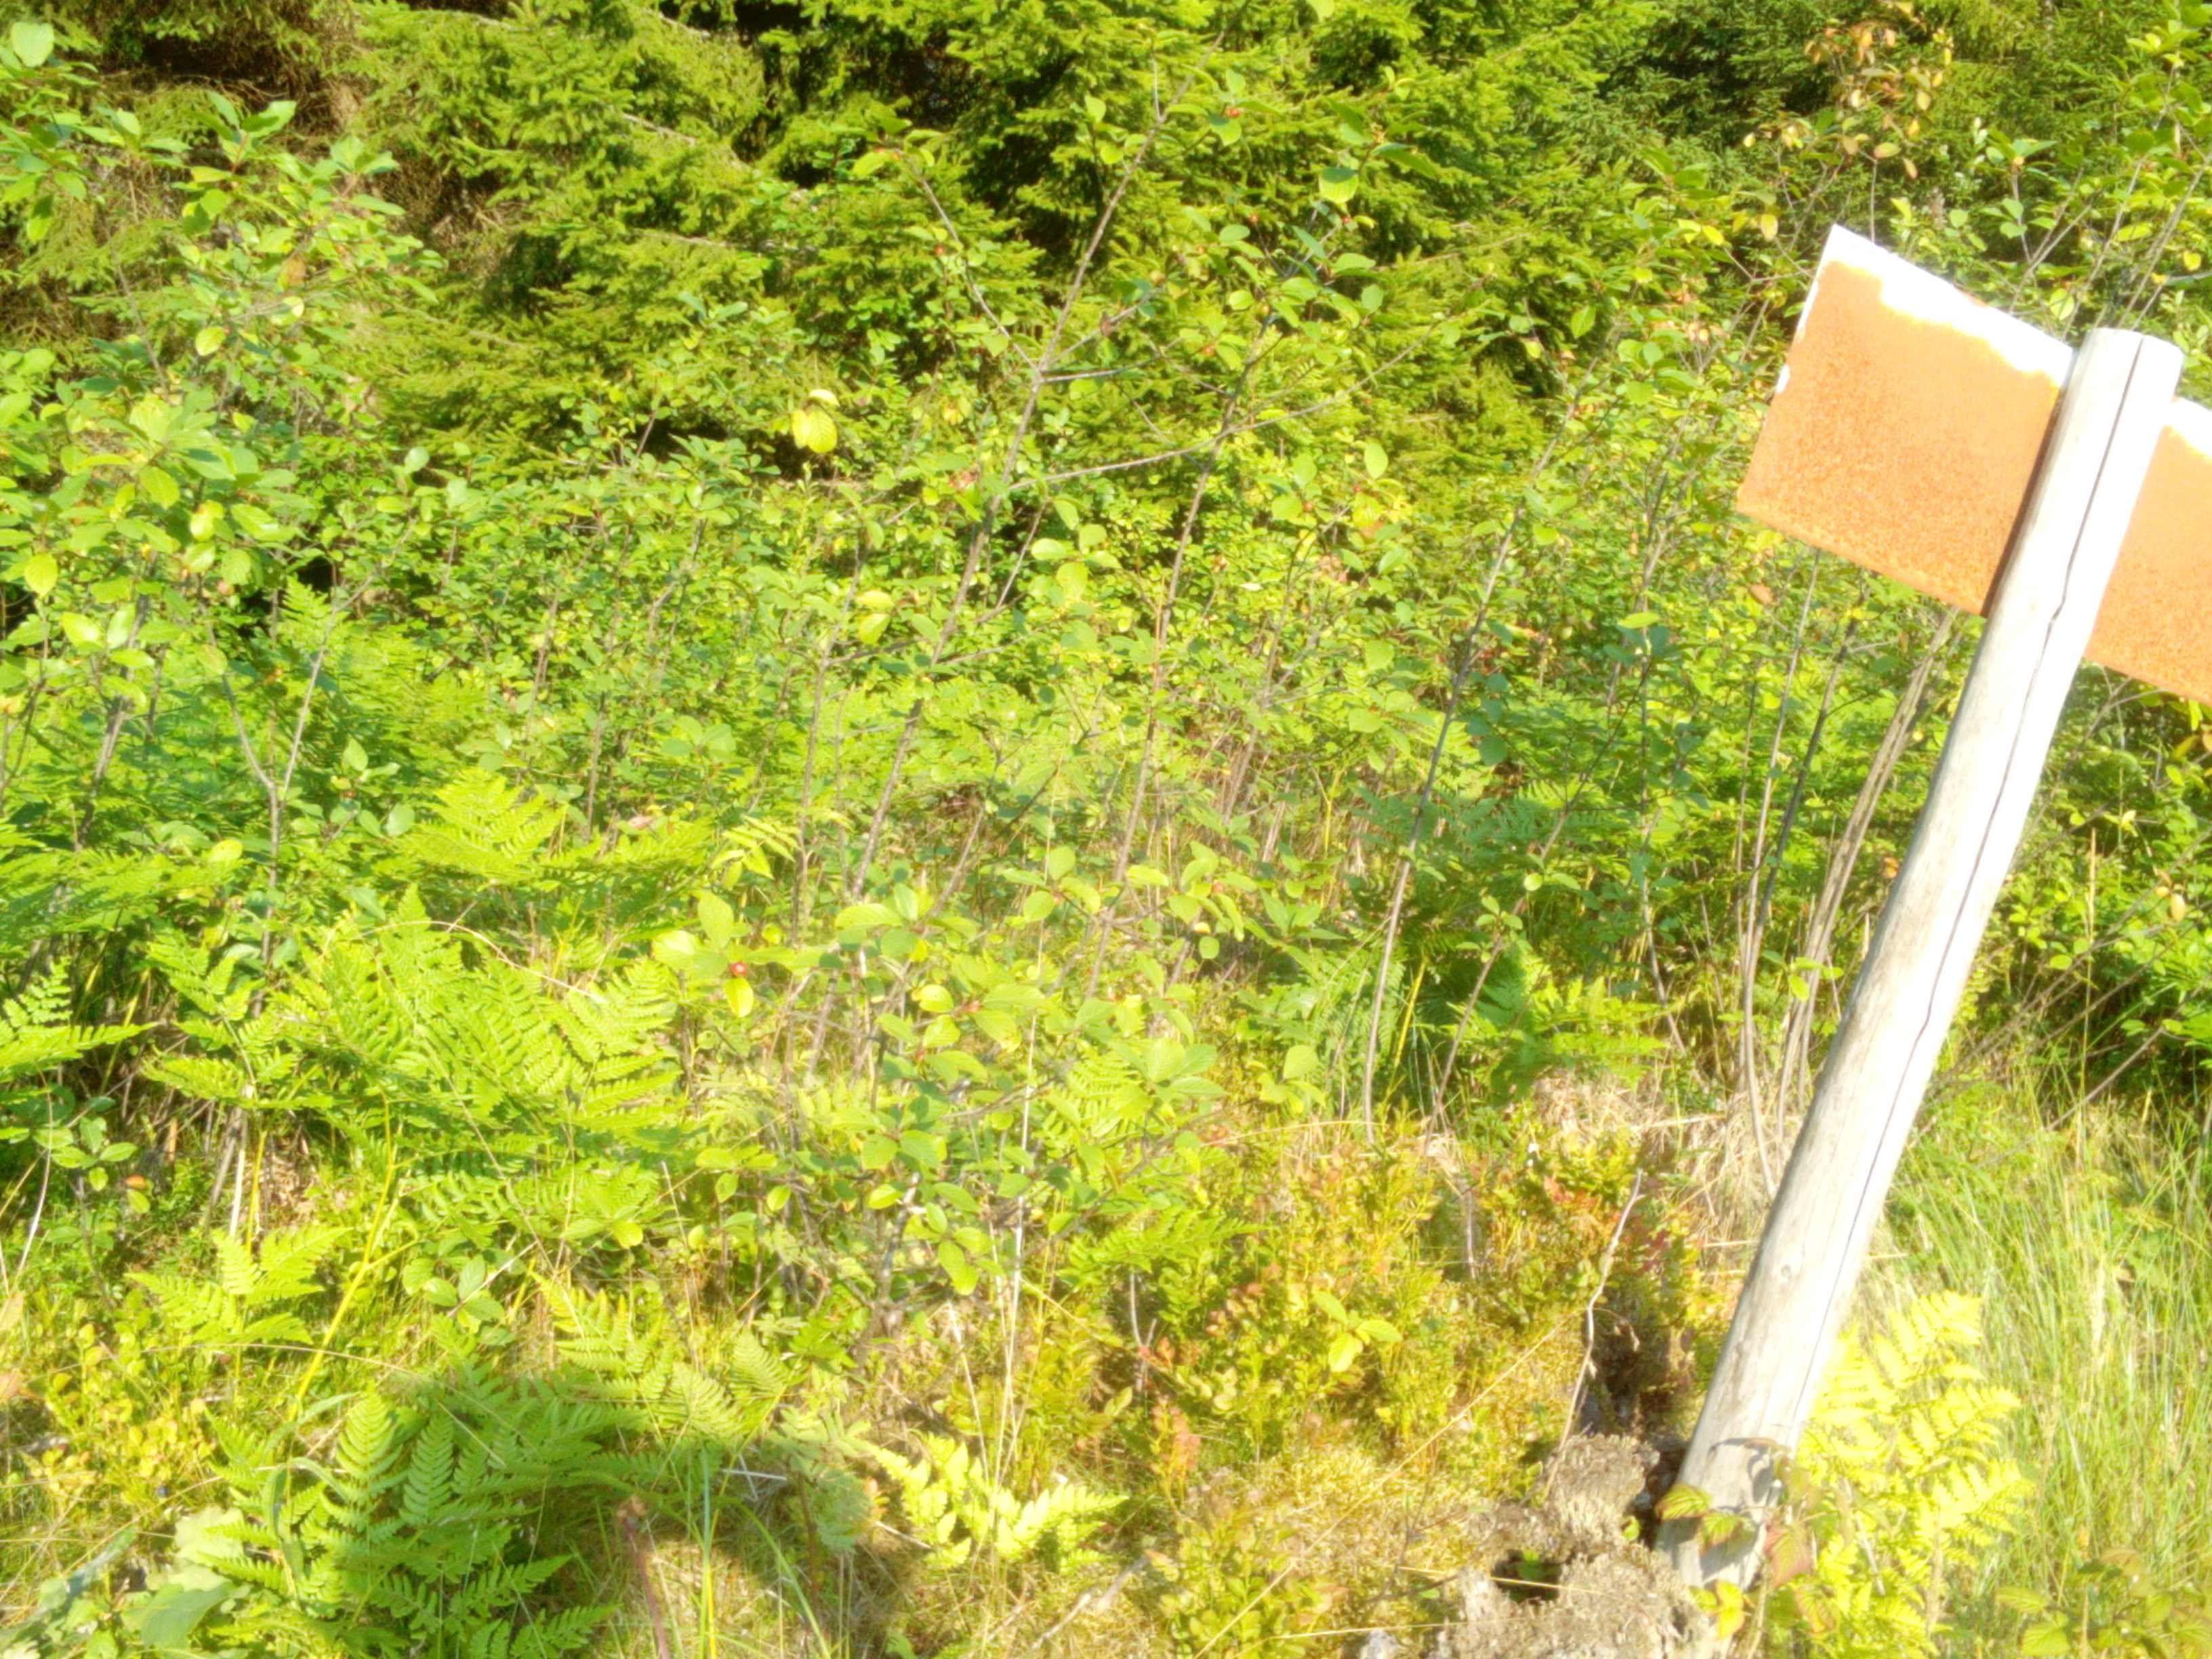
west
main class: Grassland
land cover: Grassland with sparse tree/shrub cover
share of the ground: 50 - 75 %
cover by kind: herbaceous plants 85 %, shrubs 10 %, coniferous forest trees 5 %
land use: Semi-natural and natural areas not in use
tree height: < 5 m
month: August
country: LV
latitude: 56.9158
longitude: 21.7889
